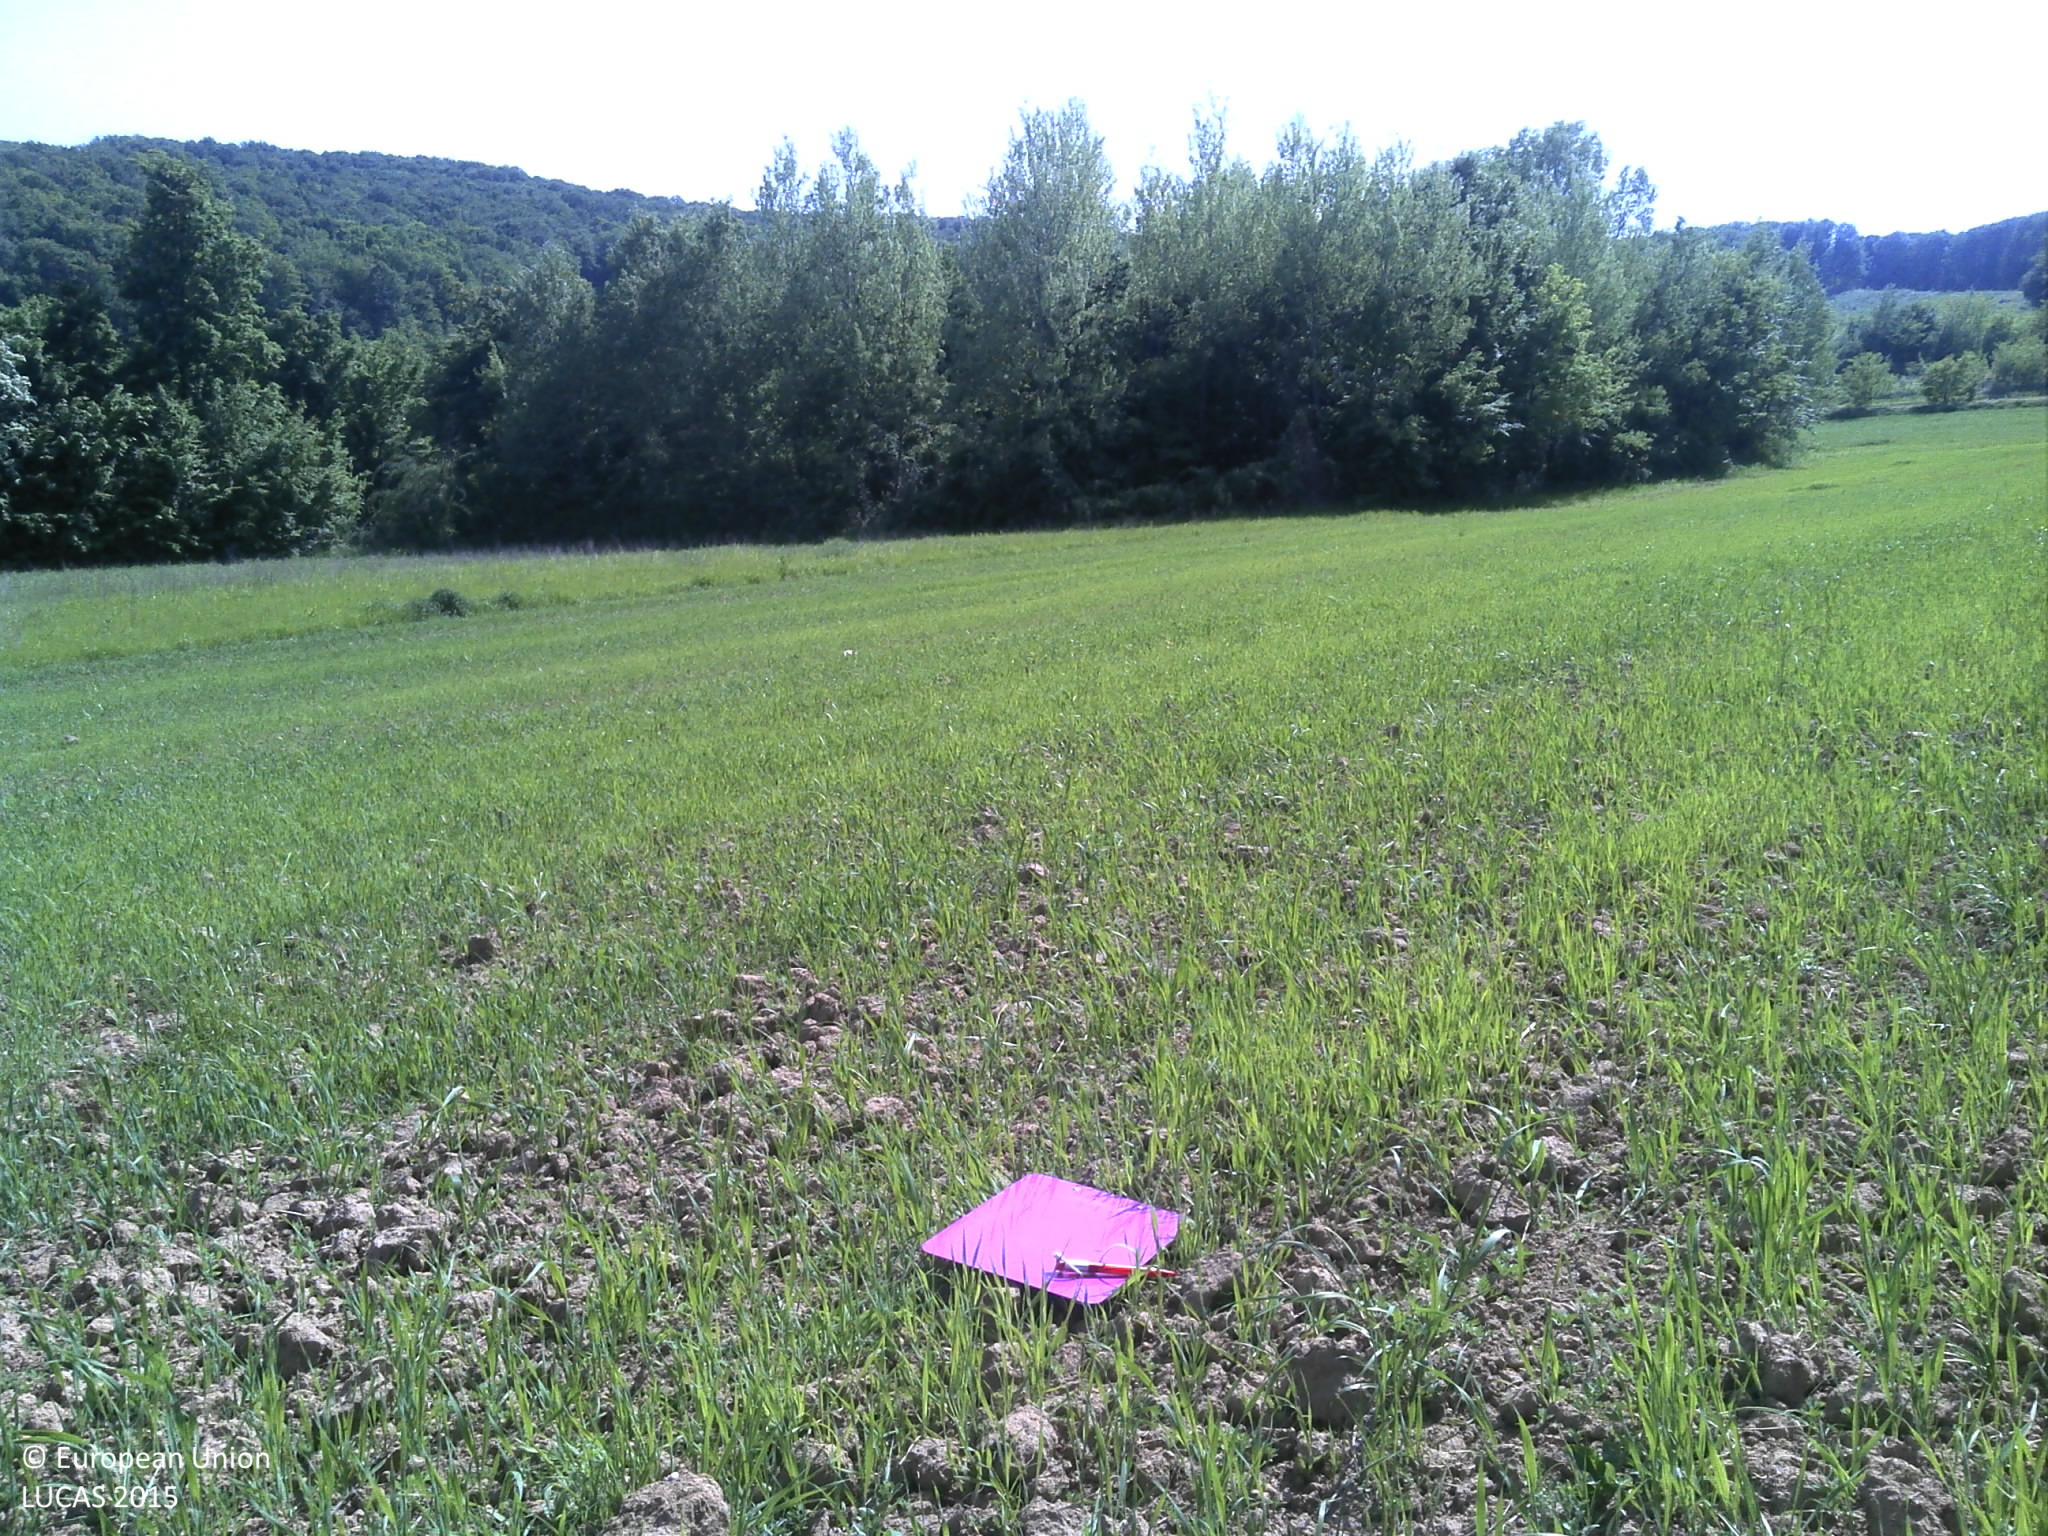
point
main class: Cropland
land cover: Common wheat
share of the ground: 25 - 50 %
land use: Agriculture (excluding fallow land and kitchen gardens)
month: May
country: HR
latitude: 45.3531
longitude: 18.1348
